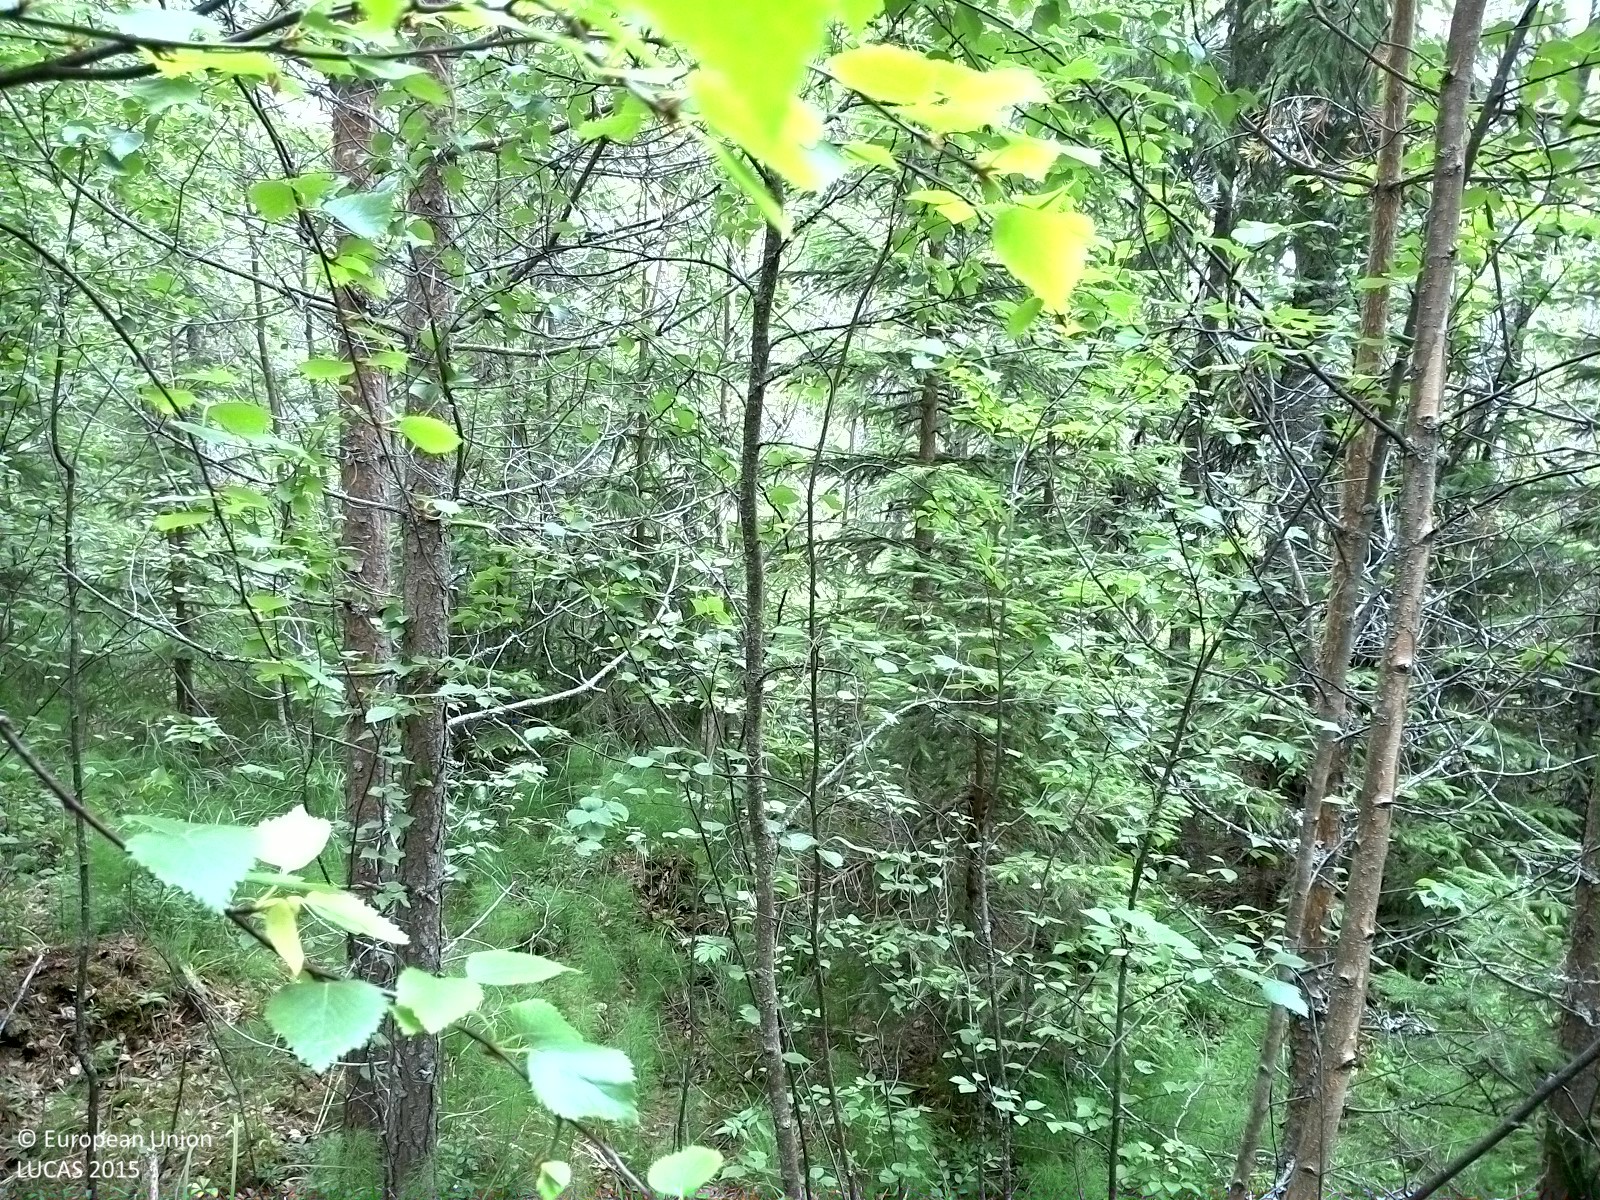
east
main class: Woodland
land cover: Other mixed woodland
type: boreal forest
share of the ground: > 75 %
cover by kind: coniferous forest trees 40 %, broadleaved forest trees 40 %, shrubs 15 %, herbaceous plants 5 %
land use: Forestry
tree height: > 5 m
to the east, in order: Other mixed woodland; Pine dominated mixed woodland; Spruce dominated mixed woodland; Pine dominated coniferous woodland; Pine dominated mixed woodland; Groves; Paved roads, cycling and walking lanes; Groves; Other mixed woodland
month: July
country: SE
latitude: 62.5224
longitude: 17.7319
